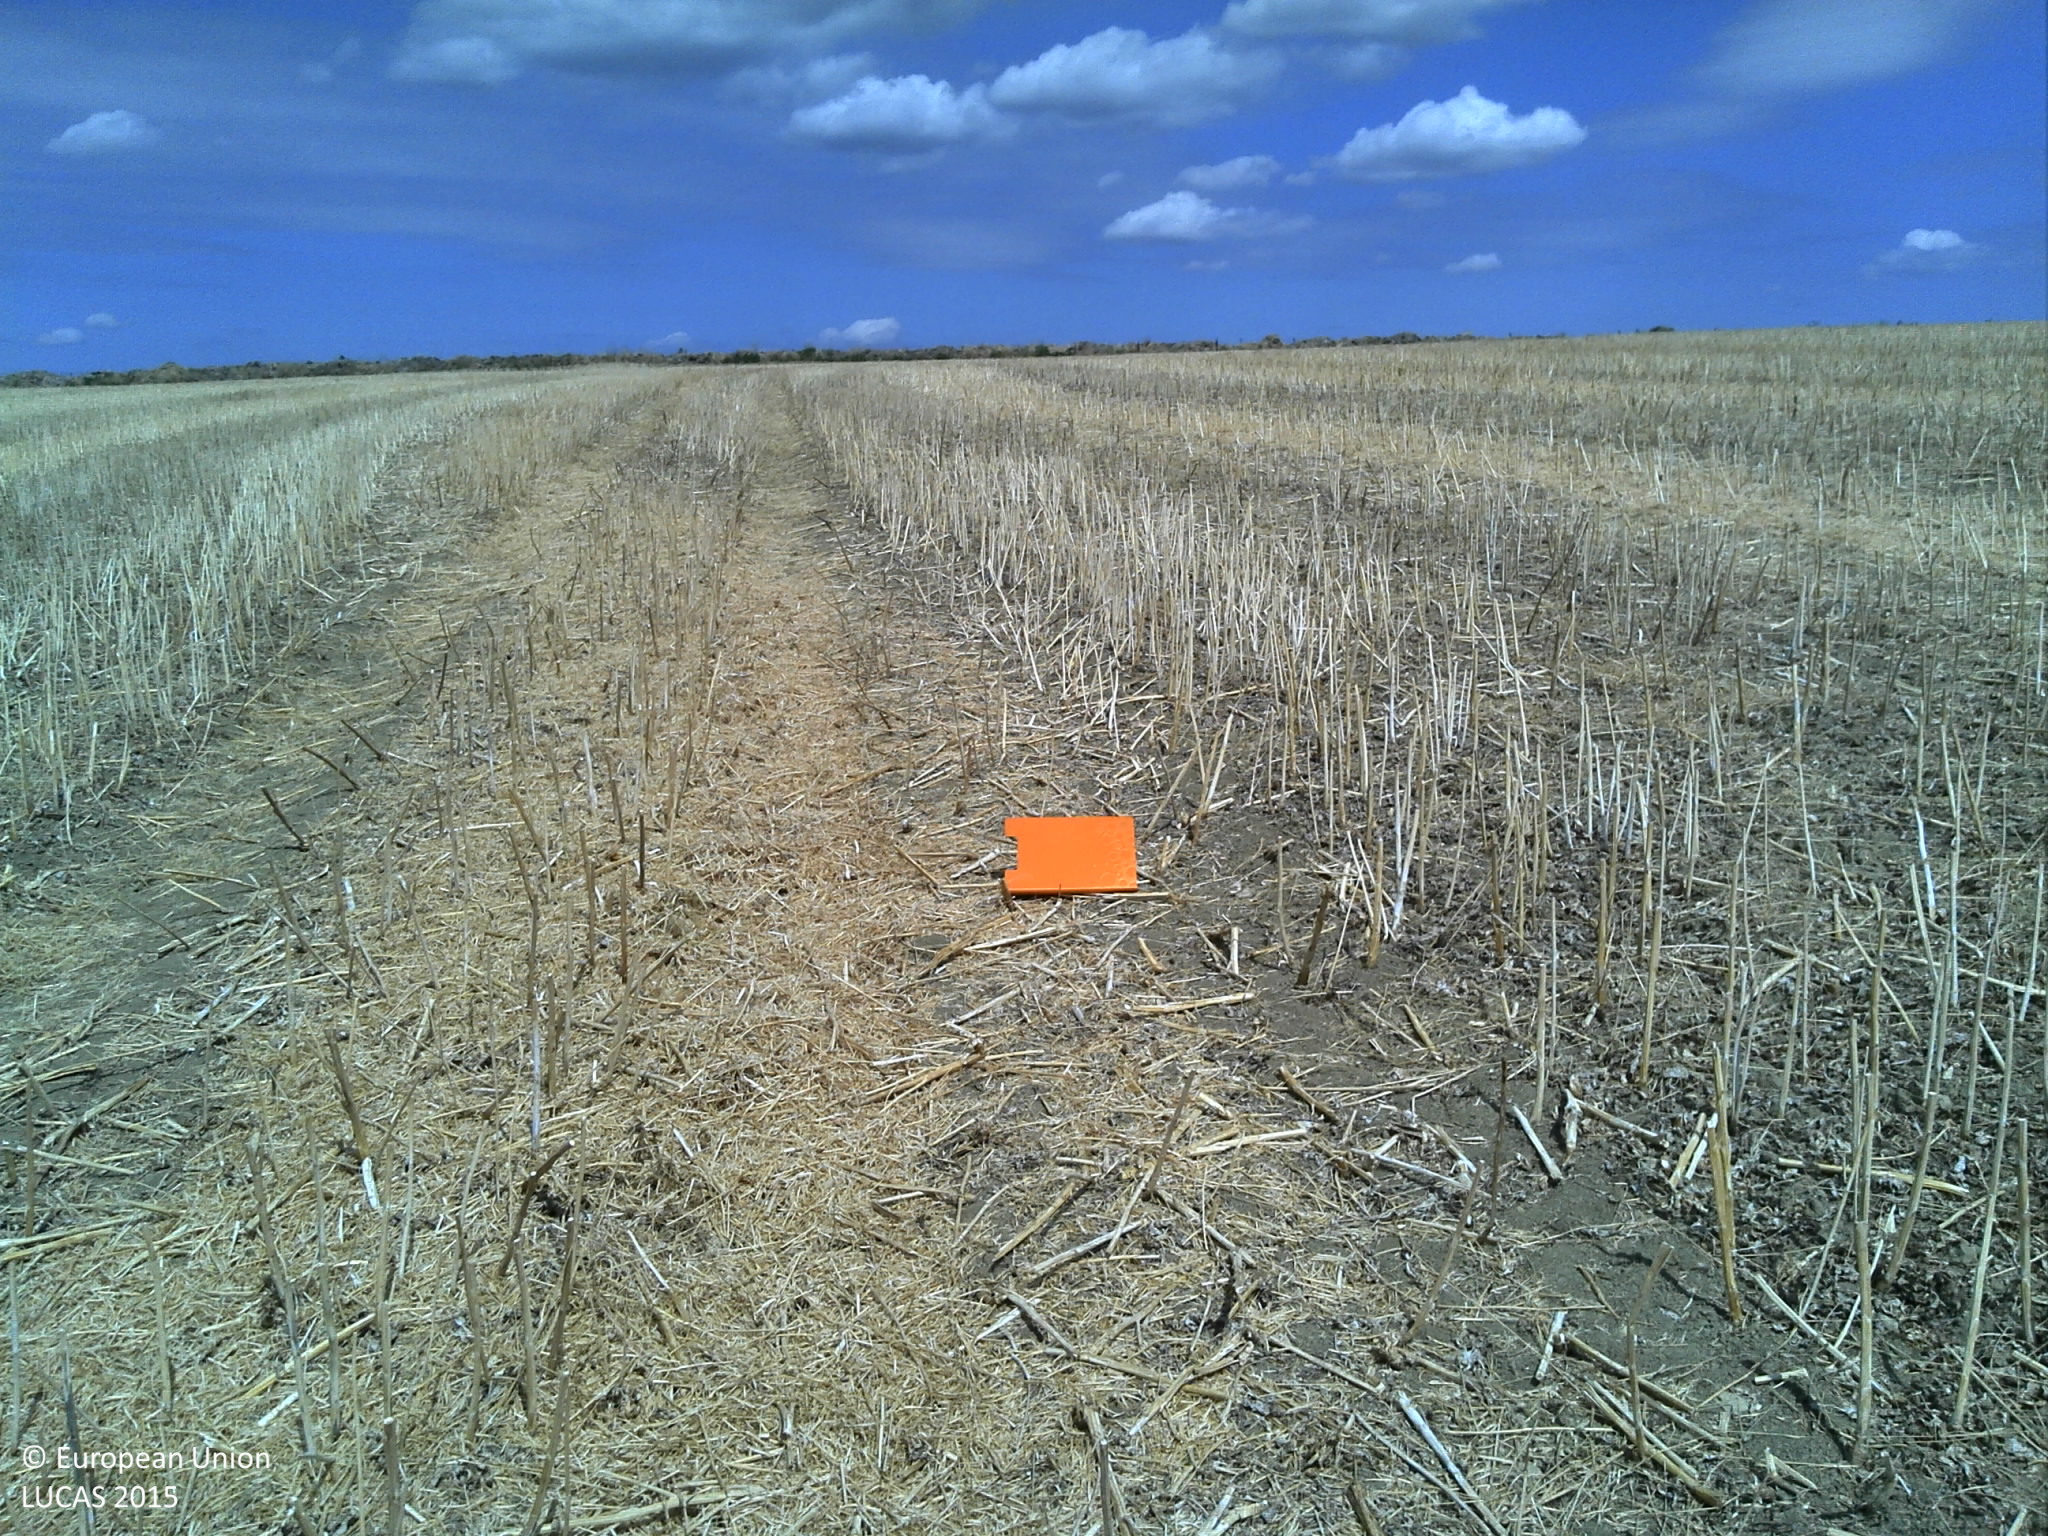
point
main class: Cropland
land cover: Rape and turnip rape
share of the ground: < 10 %
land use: Agriculture (excluding fallow land and kitchen gardens)
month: July
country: FR
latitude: 48.3499
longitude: 6.0195
